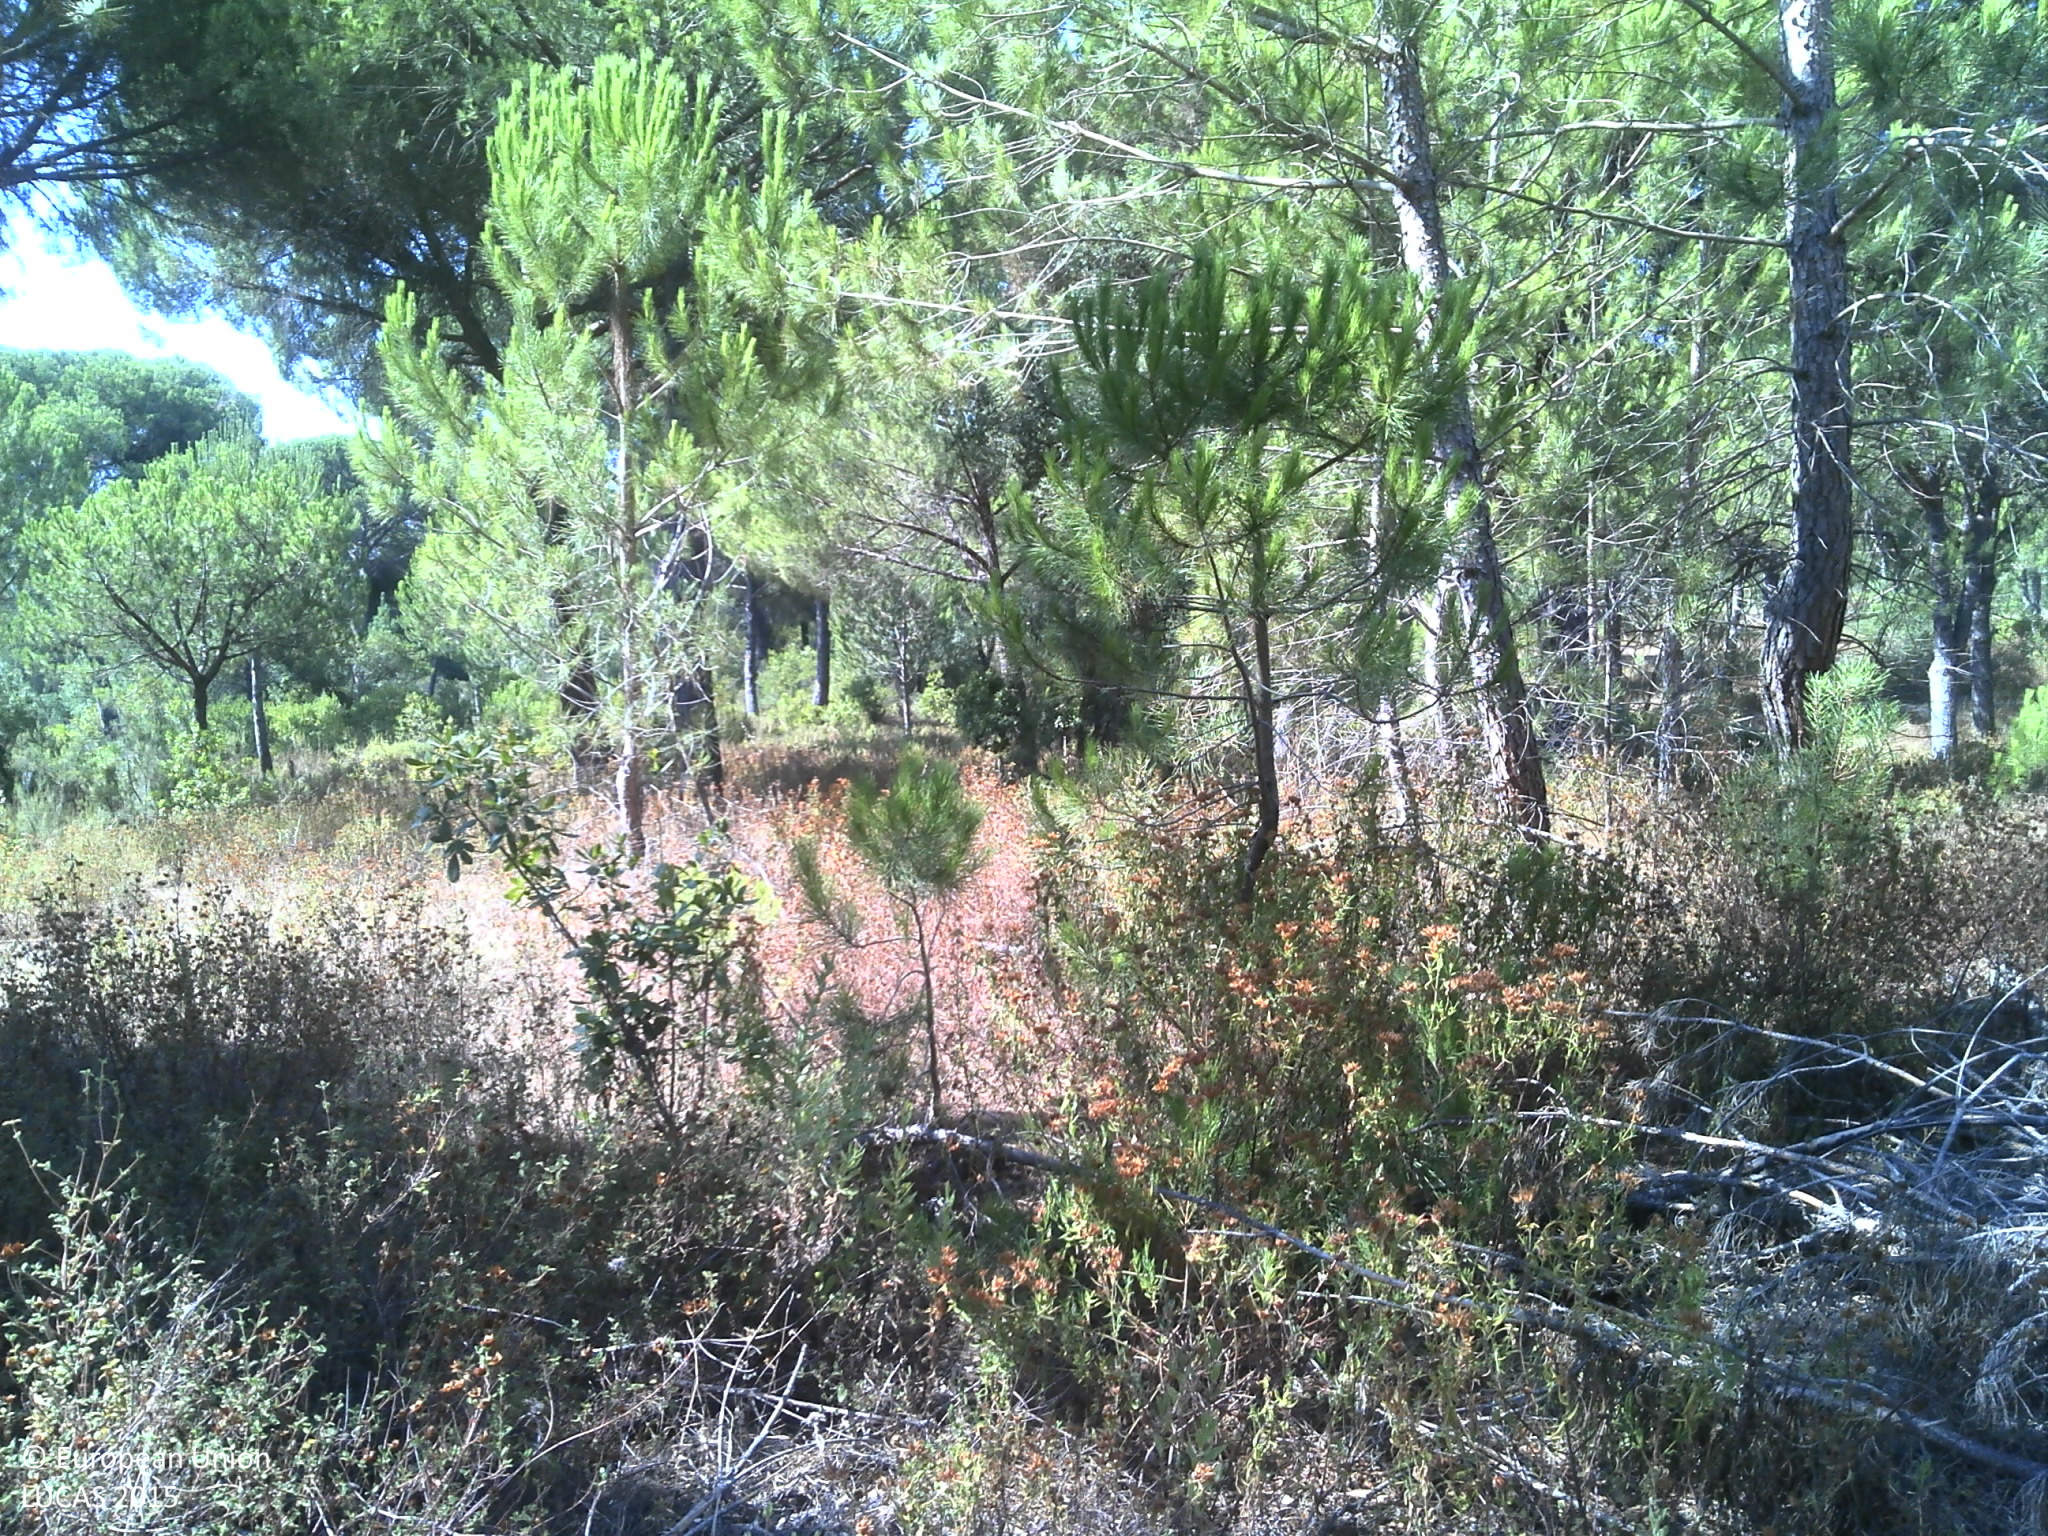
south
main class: Woodland
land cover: Pine dominated coniferous woodland
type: coniferous forest of the mediterranean region
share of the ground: 25 - 50 %
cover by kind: coniferous forest trees 45 %, unconsolidated bare surface 30 %, herbaceous plants 15 %, shrubs 10 %
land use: Forestry
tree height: > 5 m
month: August
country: PT
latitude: 38.6440
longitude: -8.5670
